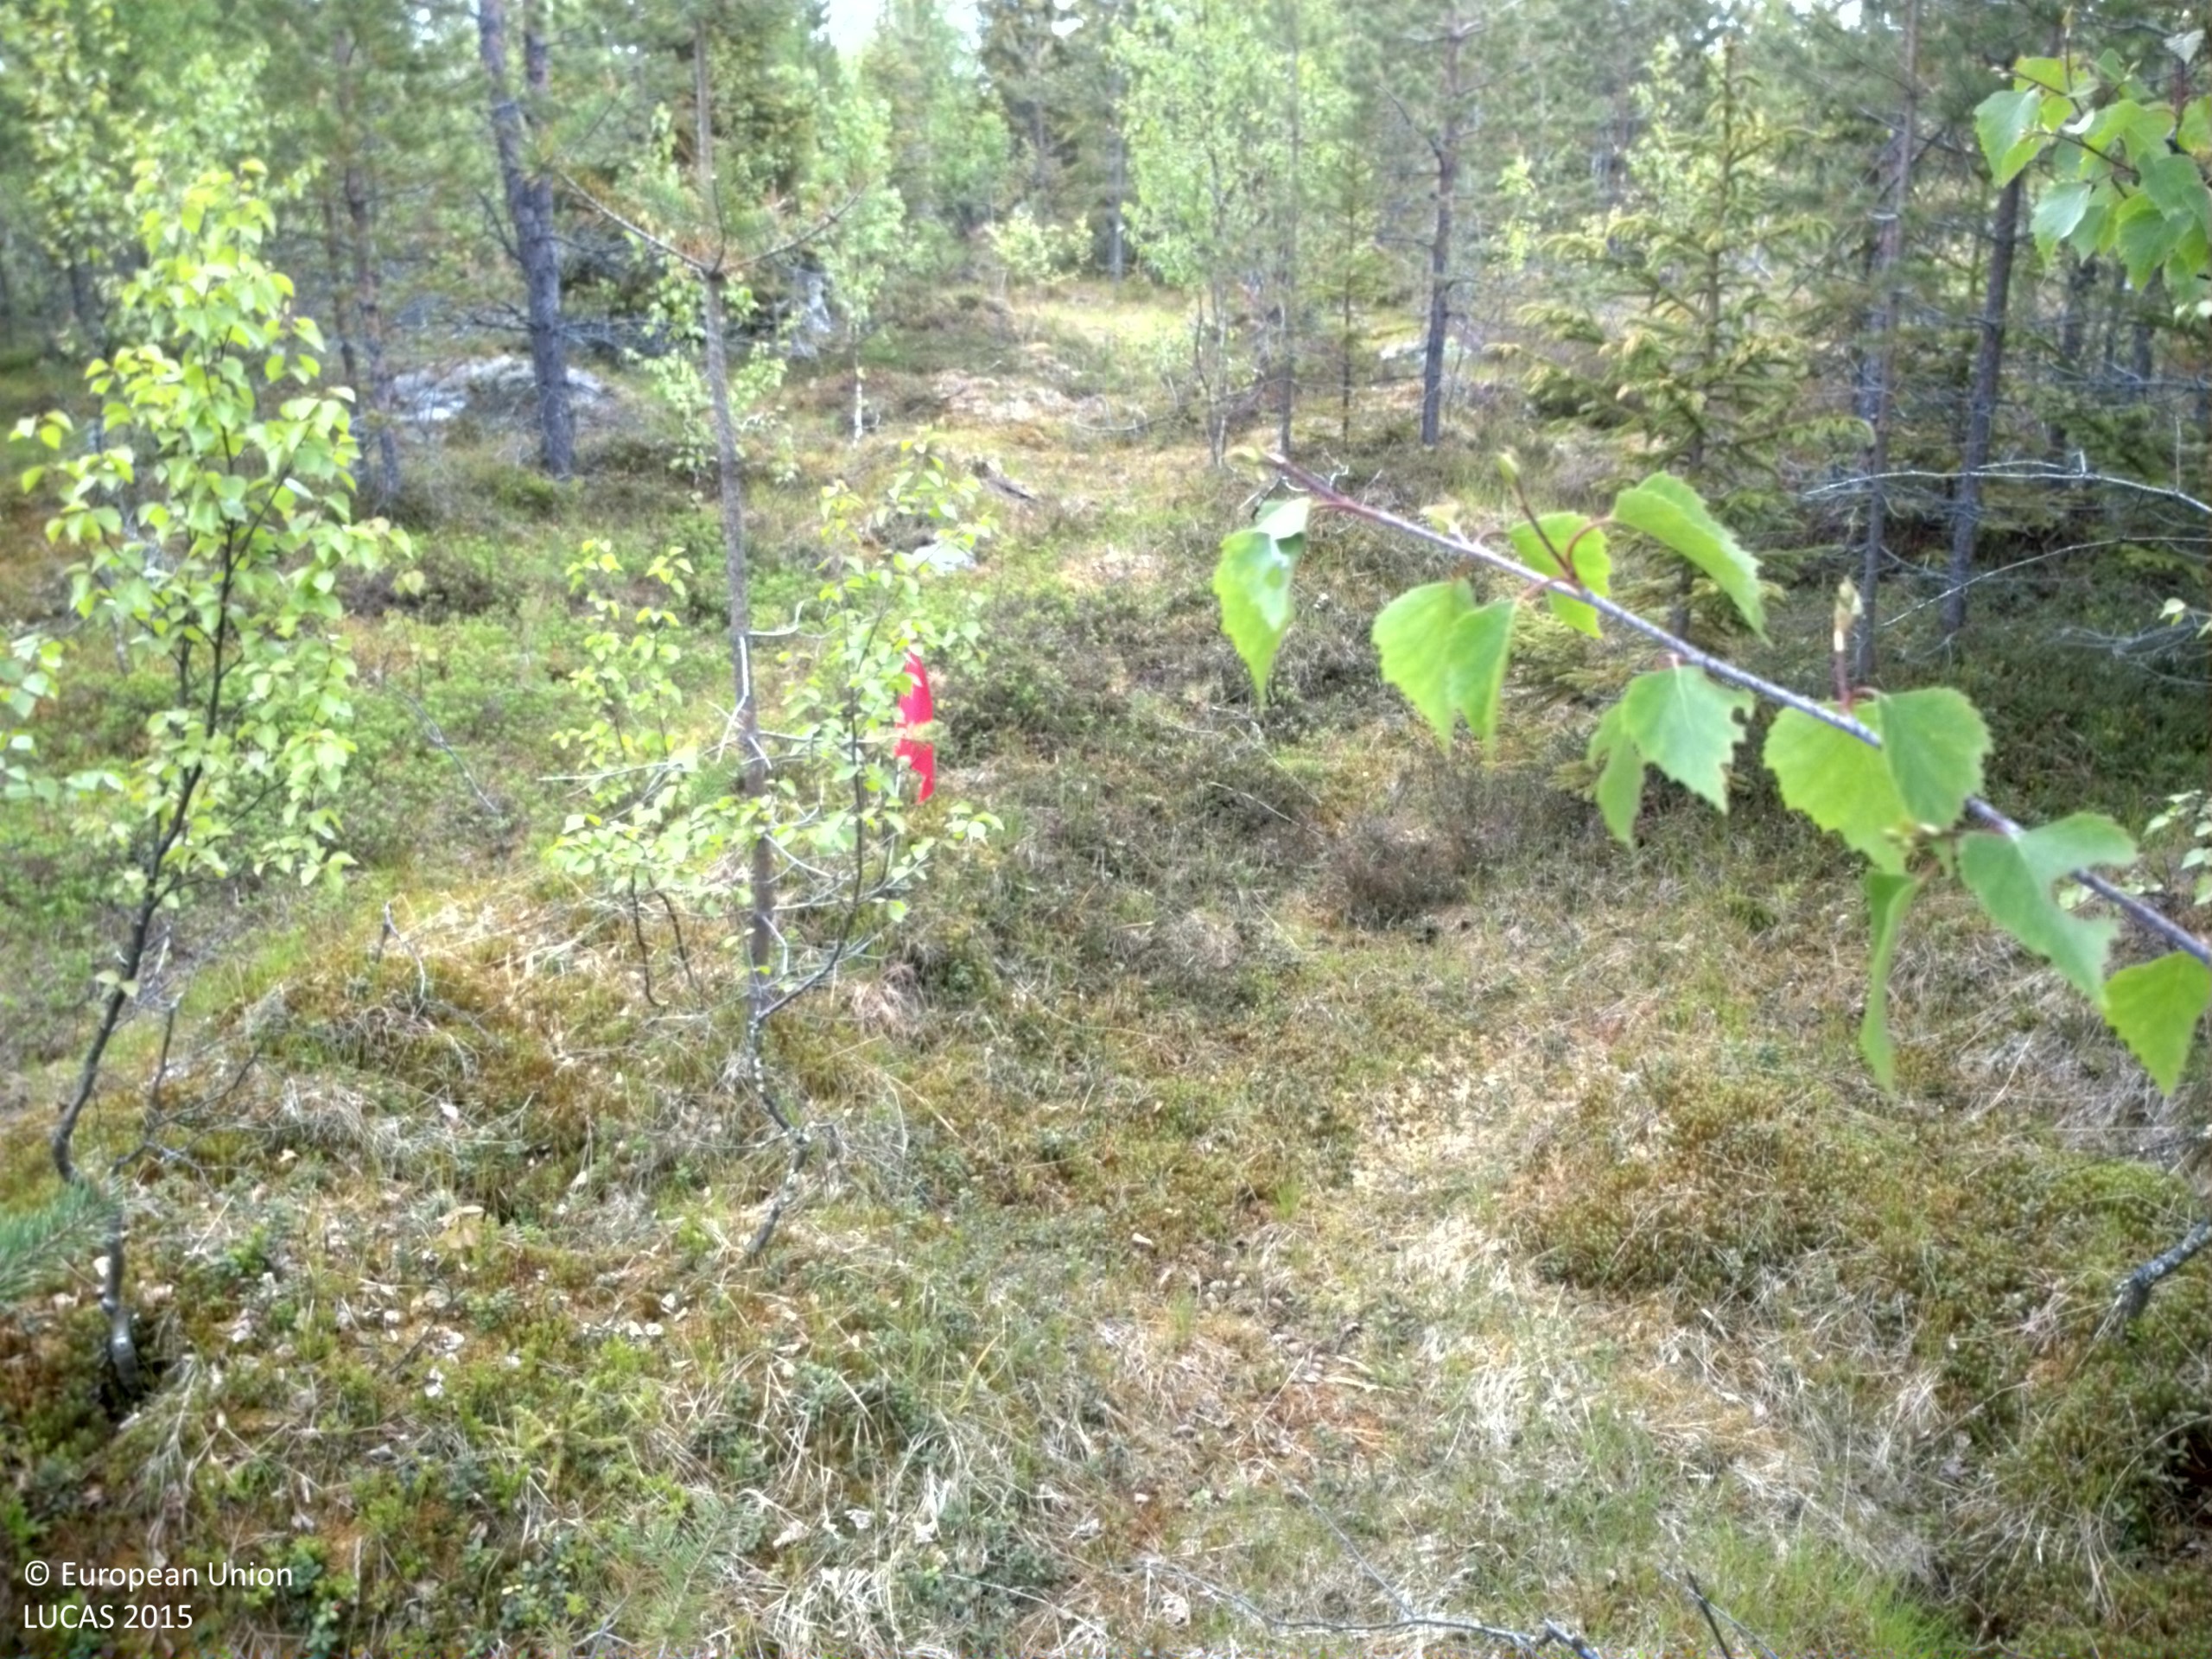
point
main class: Woodland
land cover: Pine dominated mixed woodland
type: boreal forest
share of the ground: 50 - 75 %
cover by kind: coniferous forest trees 45 %, shrubs 40 %, broadleaved forest trees 15 %
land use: Forestry
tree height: < 5 m
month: June
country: SE
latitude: 63.1626
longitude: 17.9782
